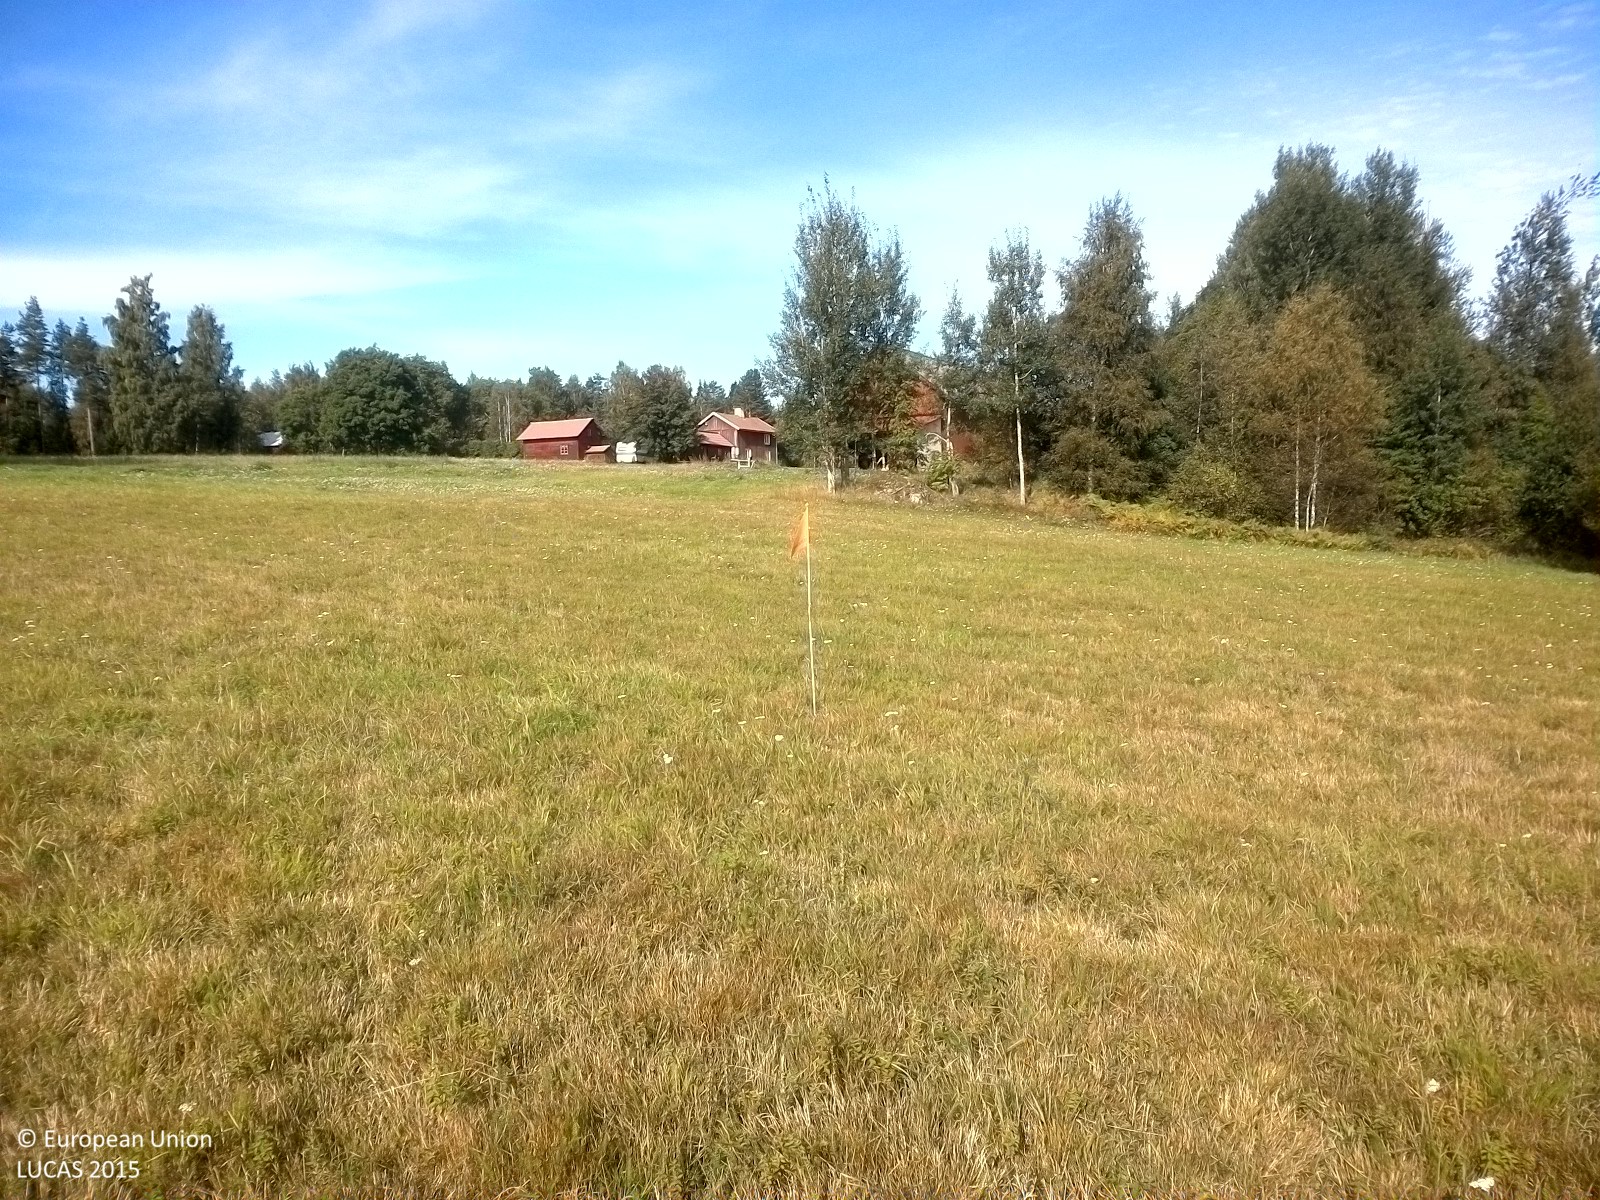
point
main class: Grassland
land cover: Grassland without tree/shrub cover
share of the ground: > 75 %
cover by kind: herbaceous plants 100 %
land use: Agriculture (excluding fallow land and kitchen gardens)
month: September
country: SE
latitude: 58.9834
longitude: 15.6824
